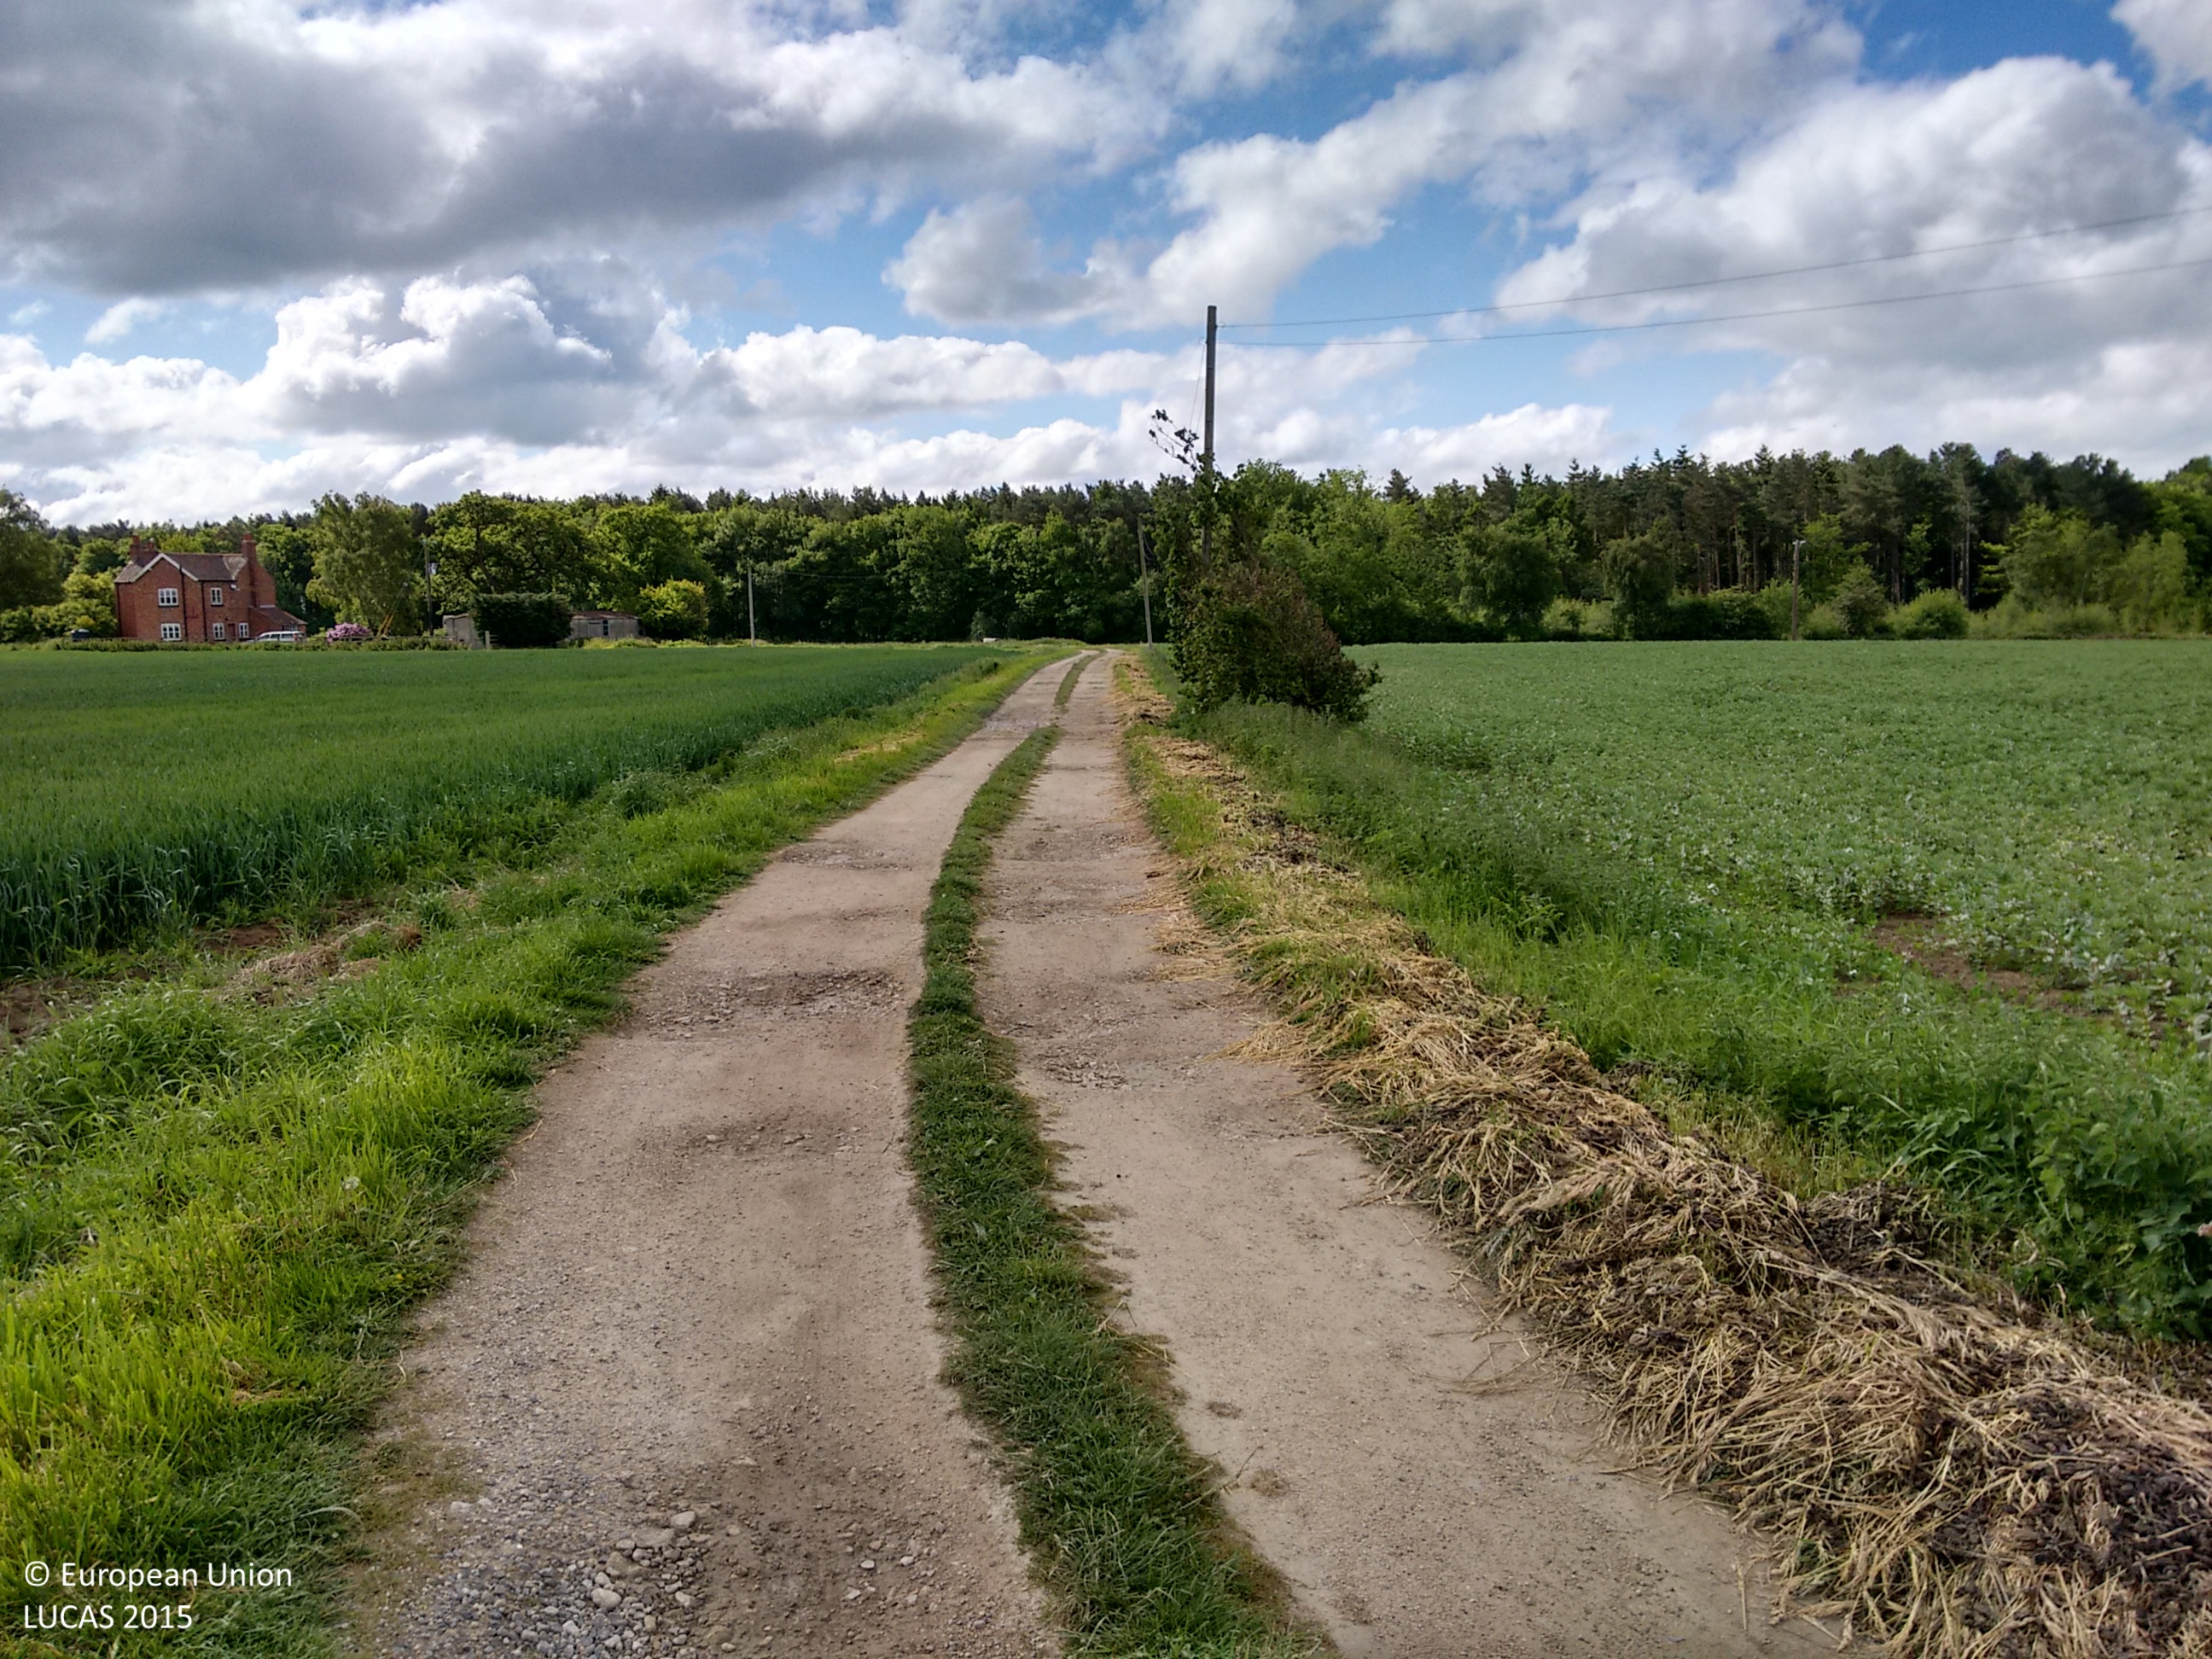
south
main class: Cropland
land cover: Common wheat
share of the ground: > 75 %
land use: Agriculture (excluding fallow land and kitchen gardens)
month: June
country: GB
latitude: 54.0652
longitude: -1.1528
